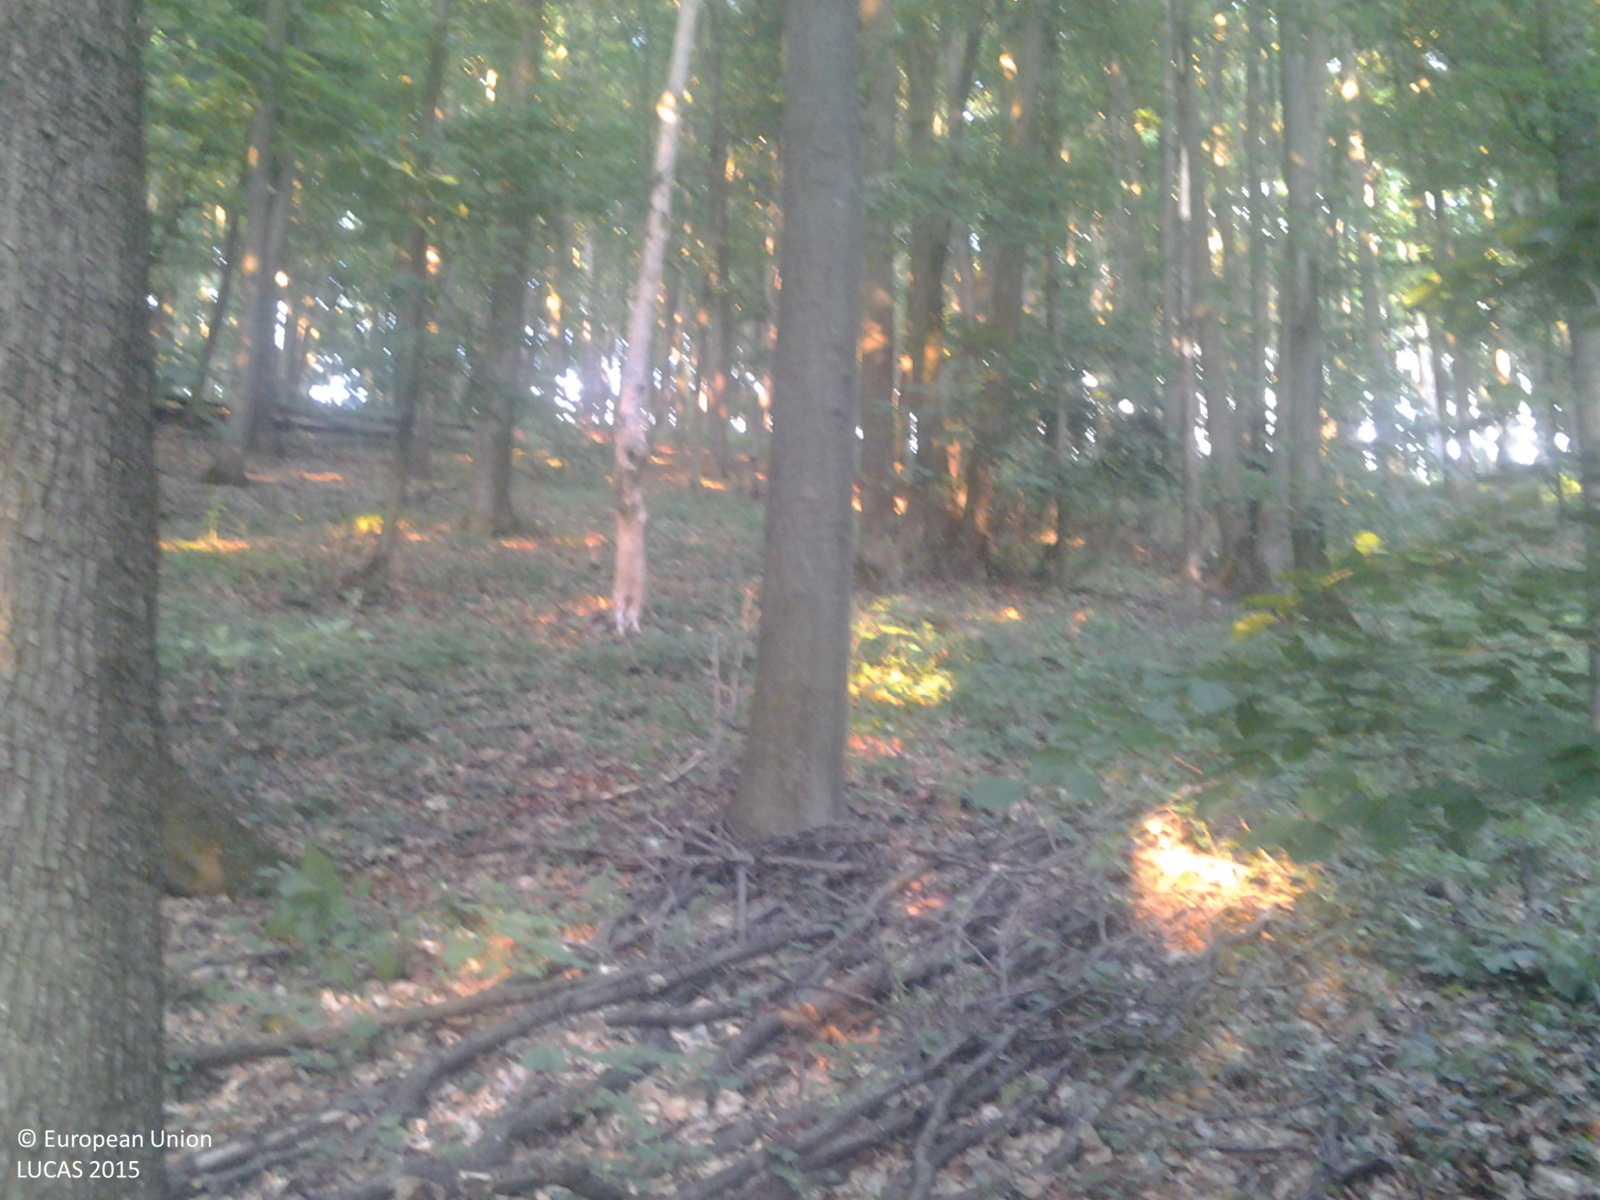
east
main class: Woodland
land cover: Broadleaved woodland
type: beech forest
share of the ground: > 75 %
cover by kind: broadleaved forest trees 100 %
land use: Forestry
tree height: > 5 m
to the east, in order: Broadleaved woodland; Grassland without tree/shrub cover
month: June
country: RO
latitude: 46.3491
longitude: 27.1610
